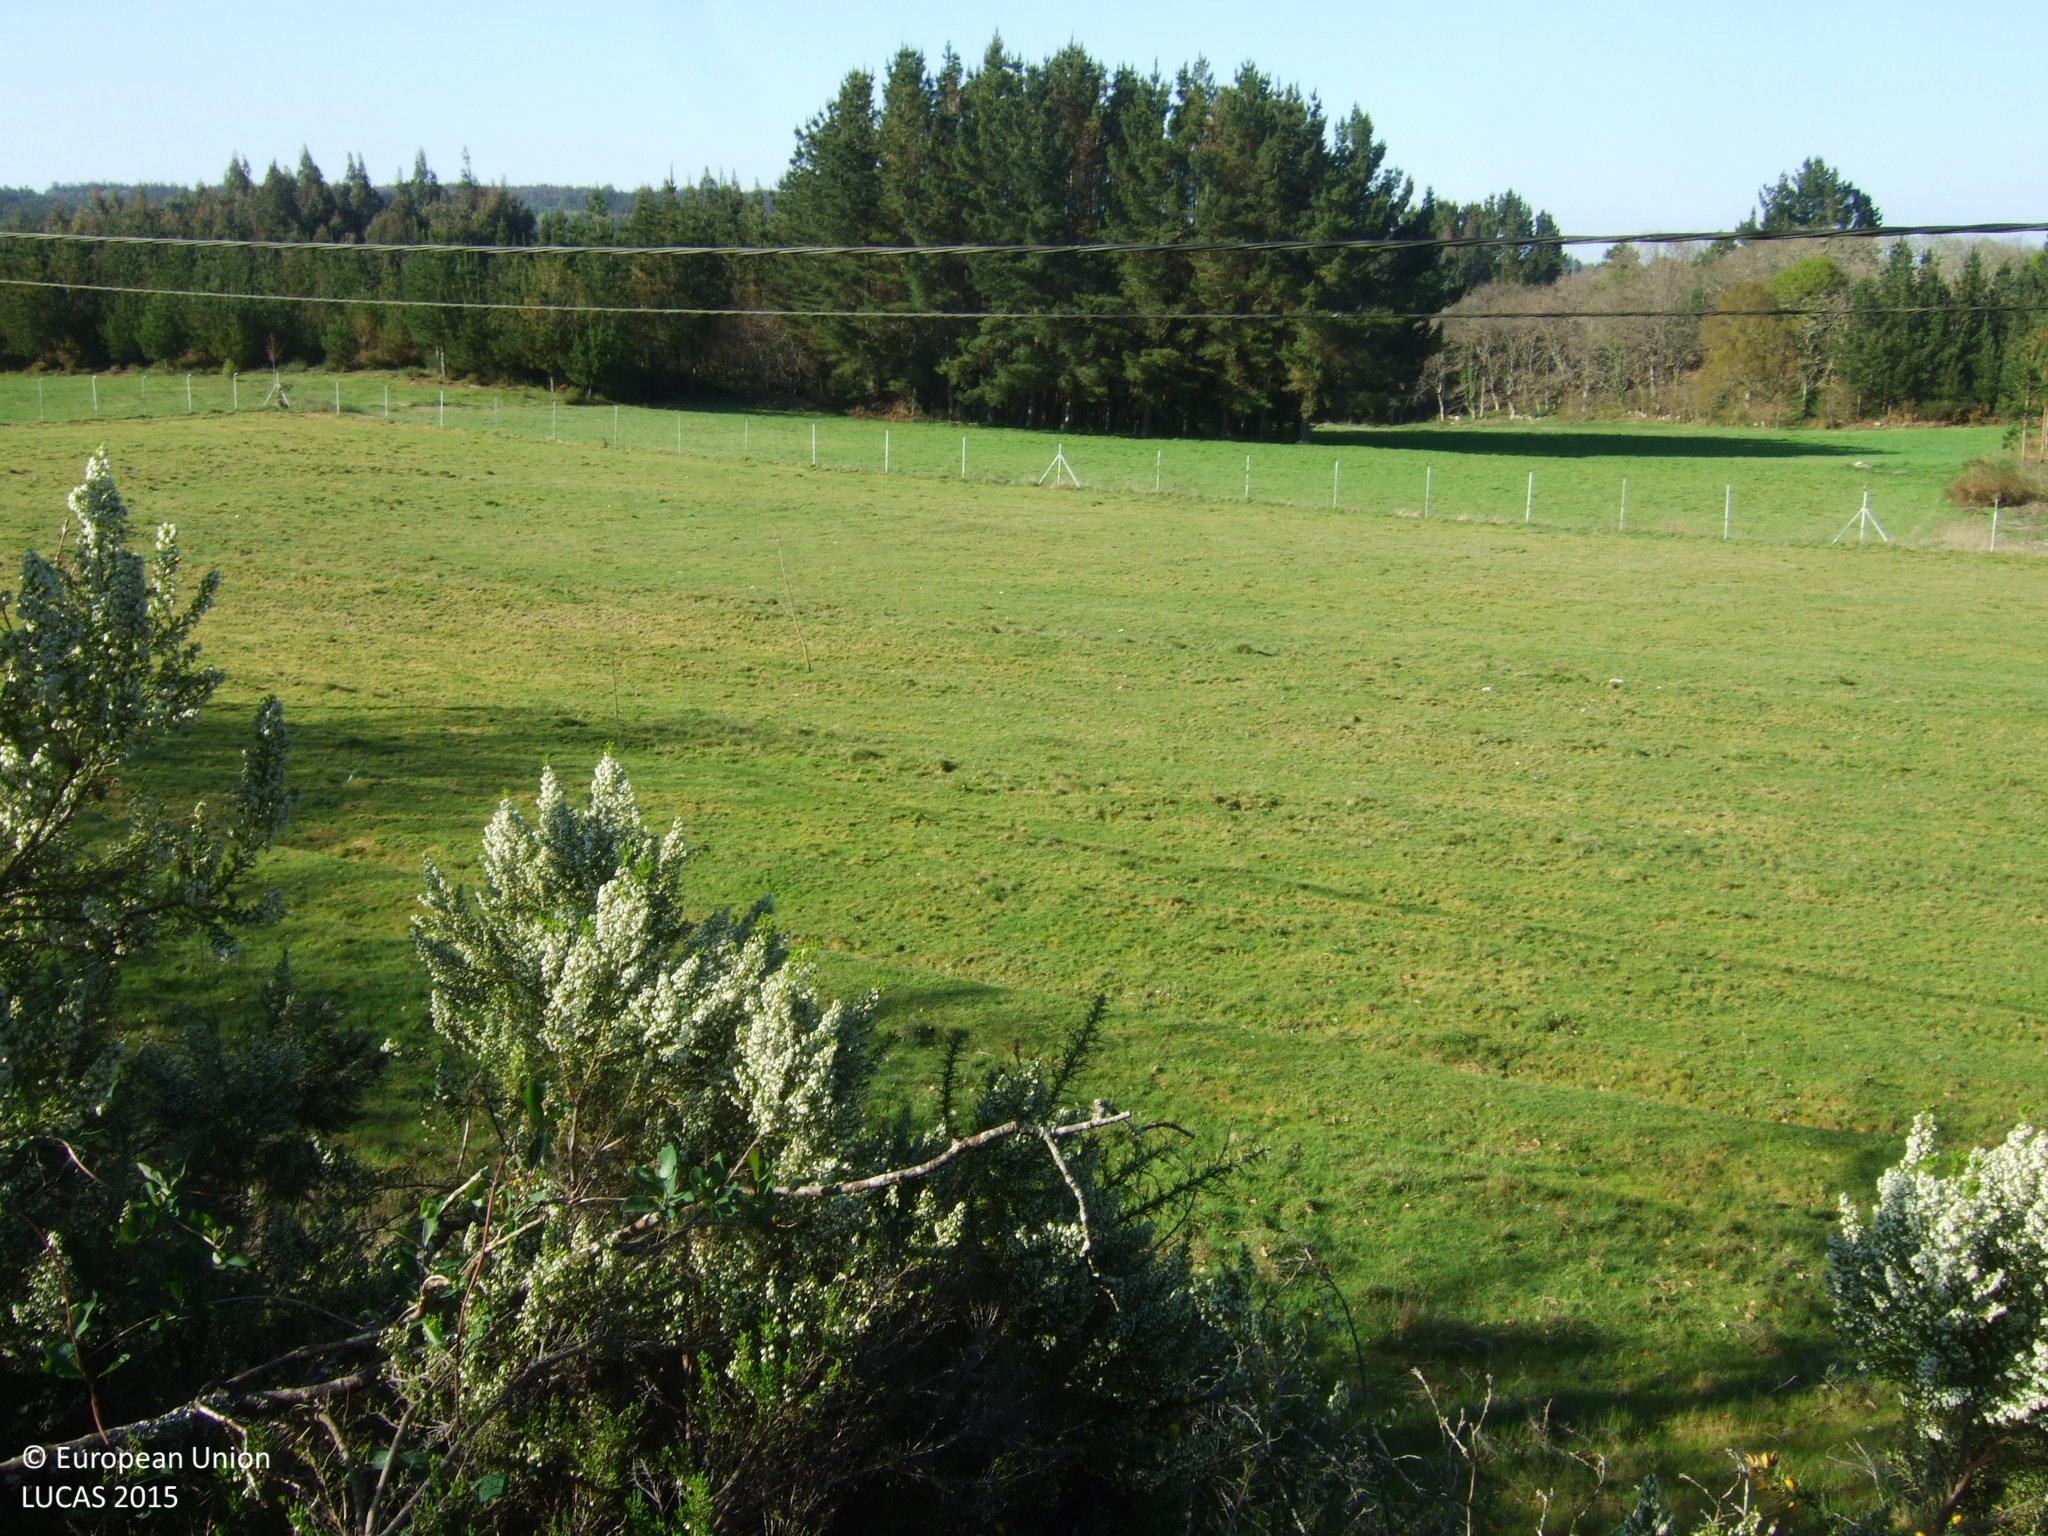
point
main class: Grassland
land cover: Grassland without tree/shrub cover
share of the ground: > 75 %
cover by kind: herbaceous plants 100 %
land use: Agriculture (excluding fallow land and kitchen gardens)
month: April
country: ES
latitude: 43.0621
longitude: -7.6520
